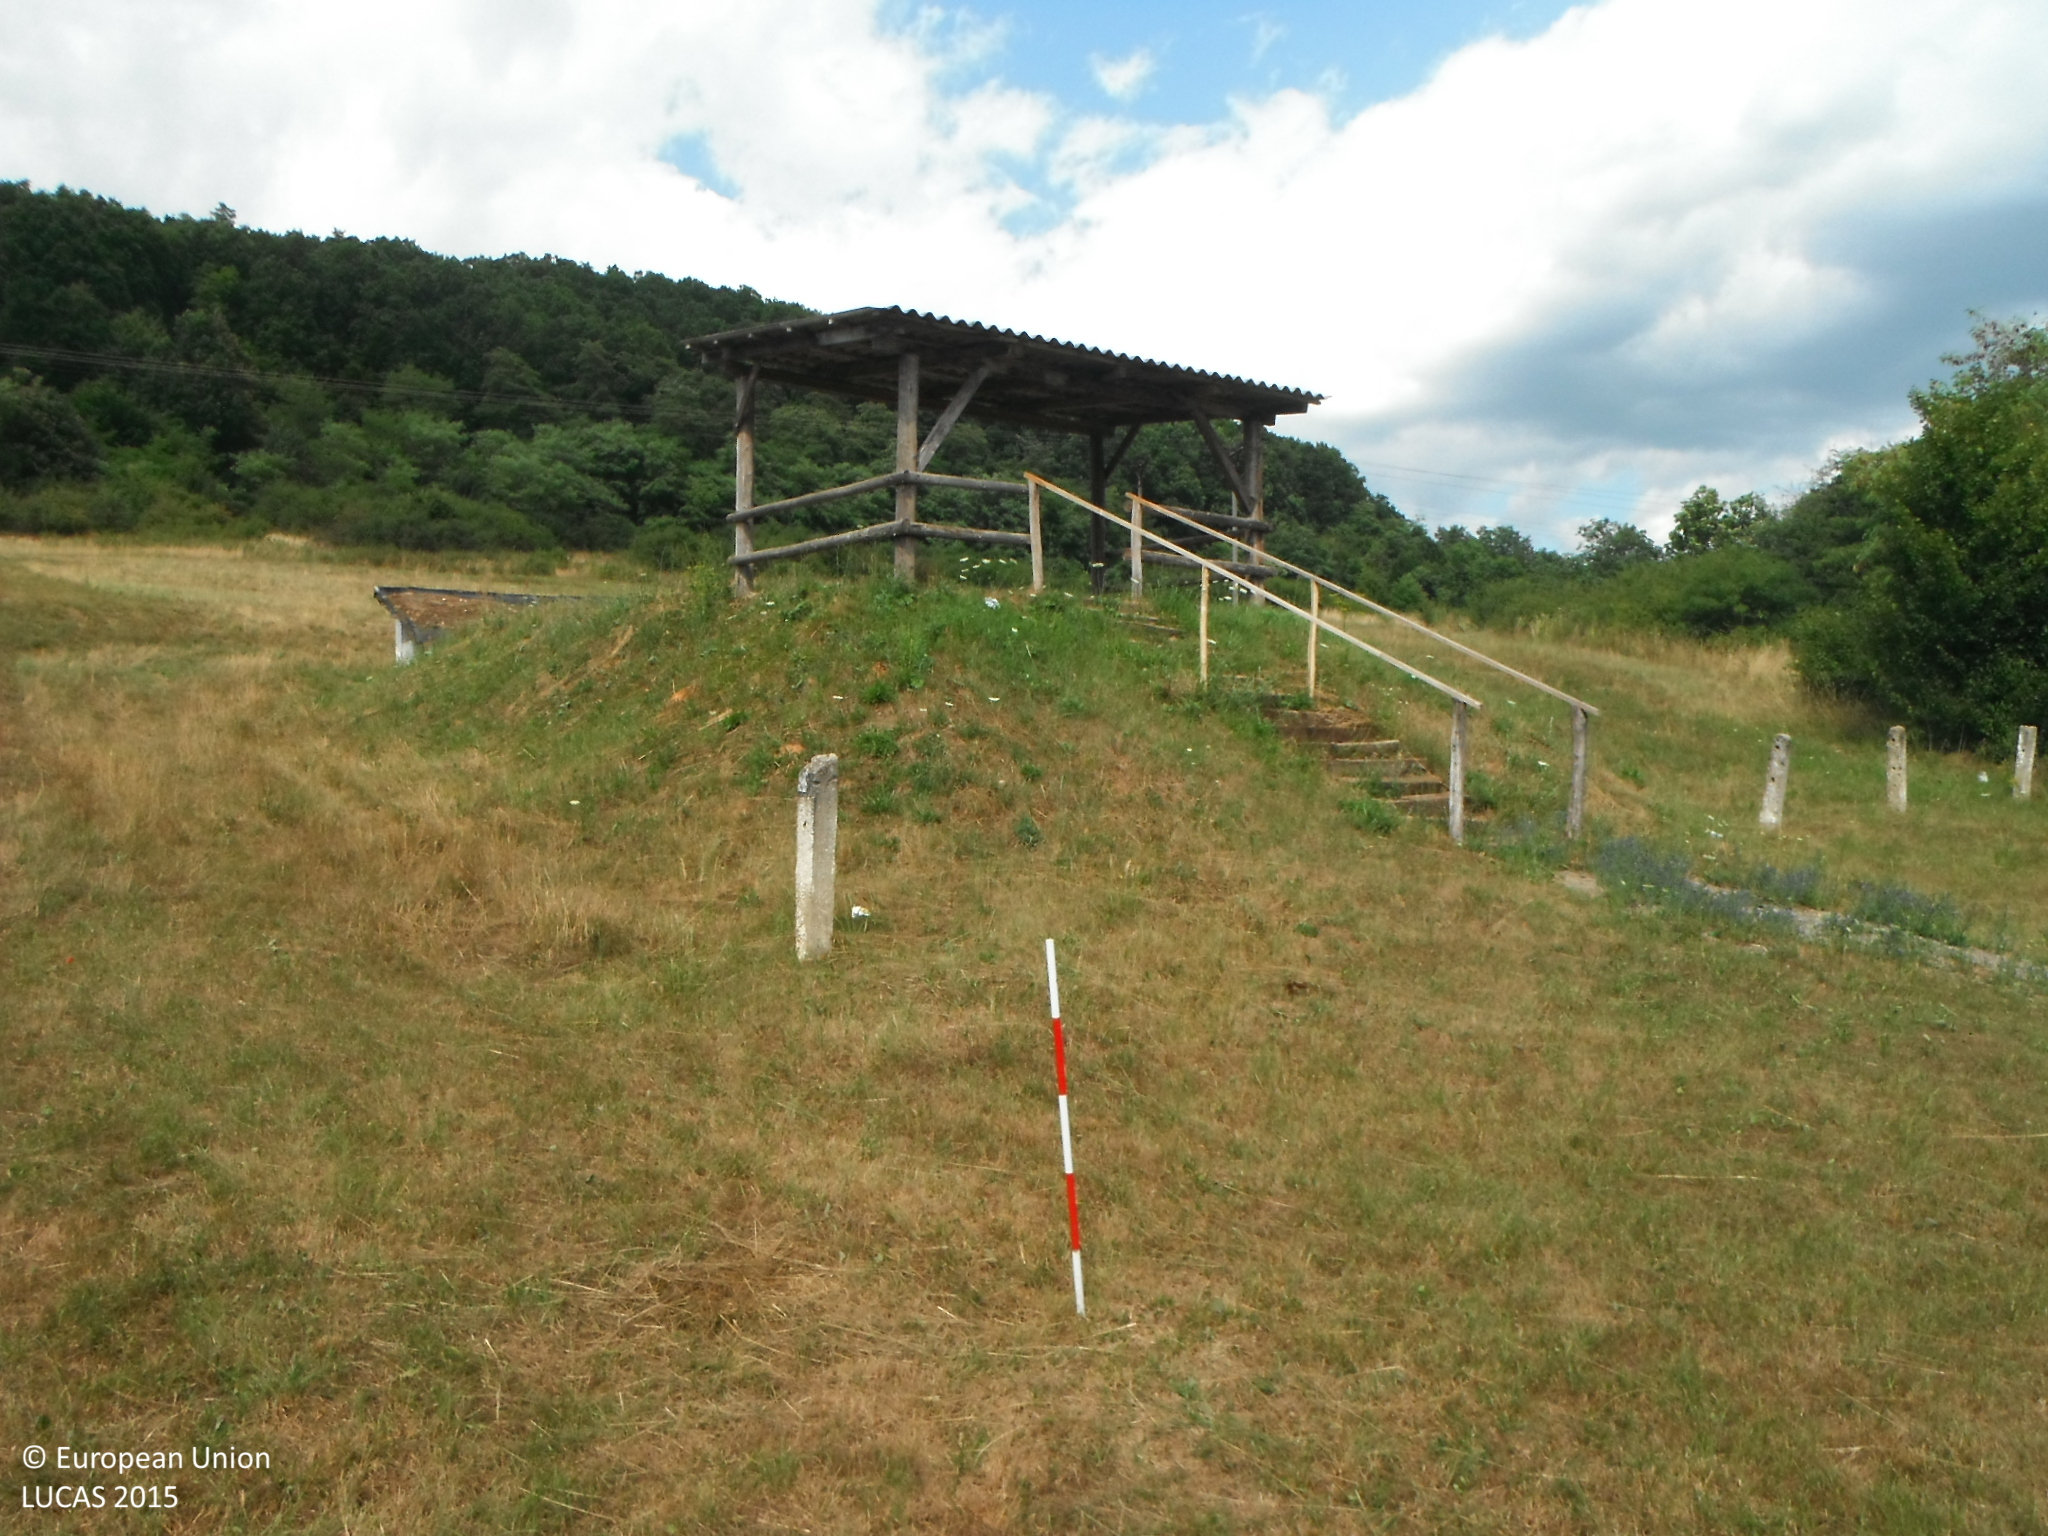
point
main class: Grassland
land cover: Grassland without tree/shrub cover
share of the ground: > 75 %
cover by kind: herbaceous plants 100 %
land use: Amenities, museums, leisure
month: July
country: SK
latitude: 48.6332
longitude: 20.2502
